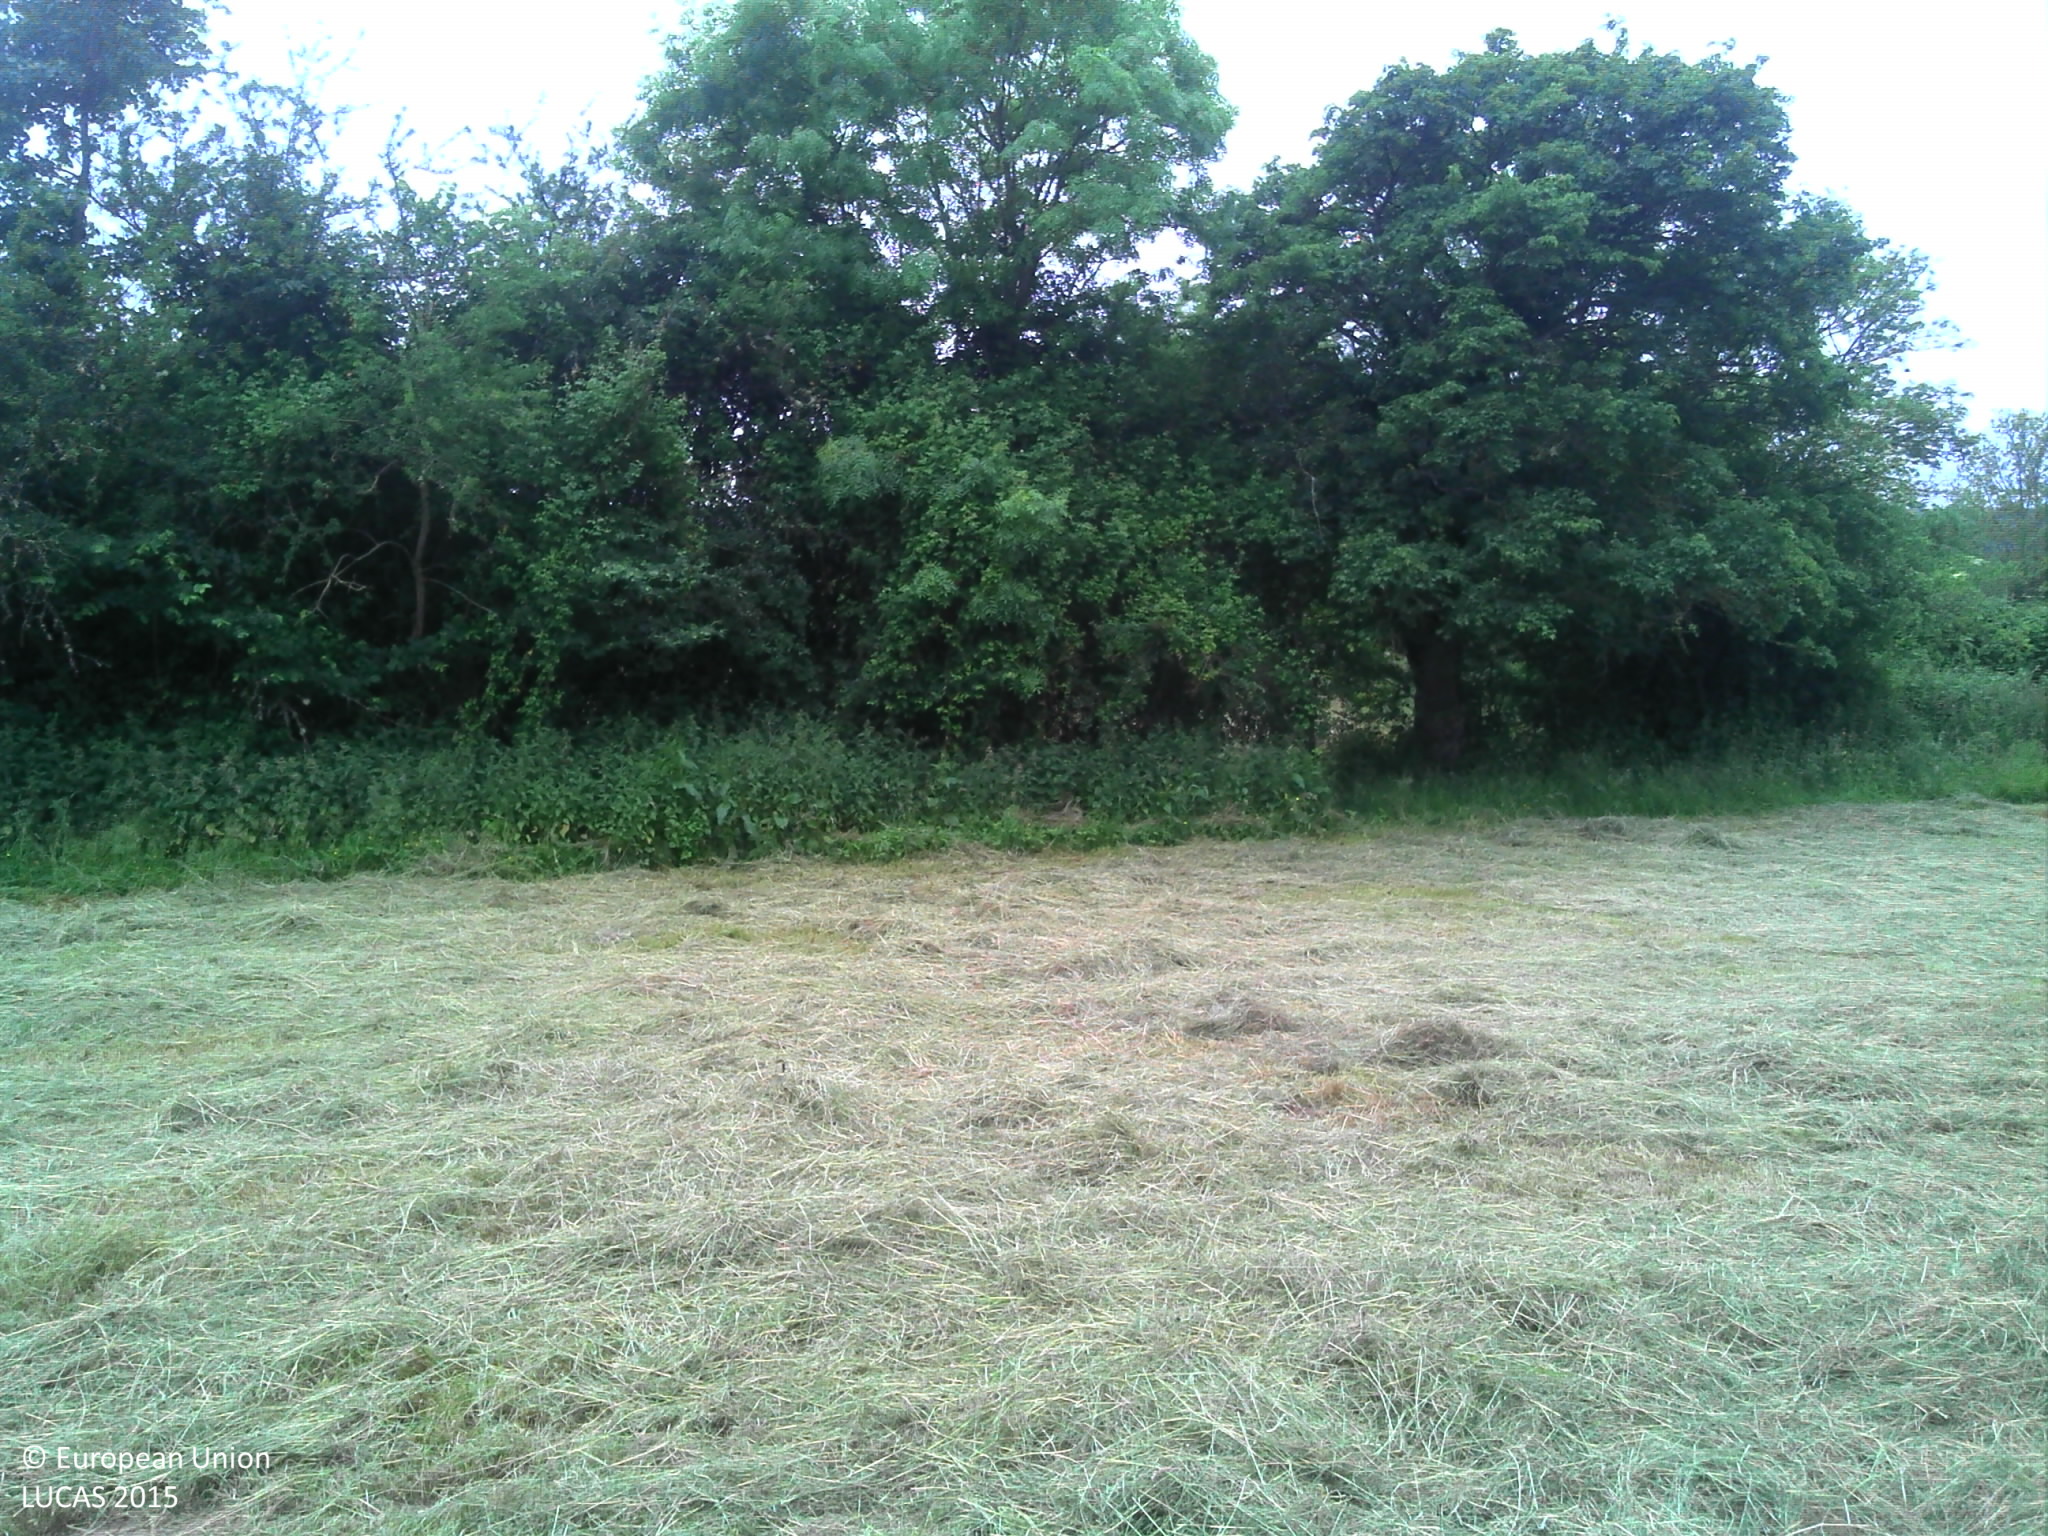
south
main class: Grassland
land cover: Grassland without tree/shrub cover
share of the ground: > 75 %
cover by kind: herbaceous plants 100 %
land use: Agriculture (excluding fallow land and kitchen gardens)
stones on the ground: < 10 %
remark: Harvested field
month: June
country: FR
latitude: 48.7541
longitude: 0.0821
